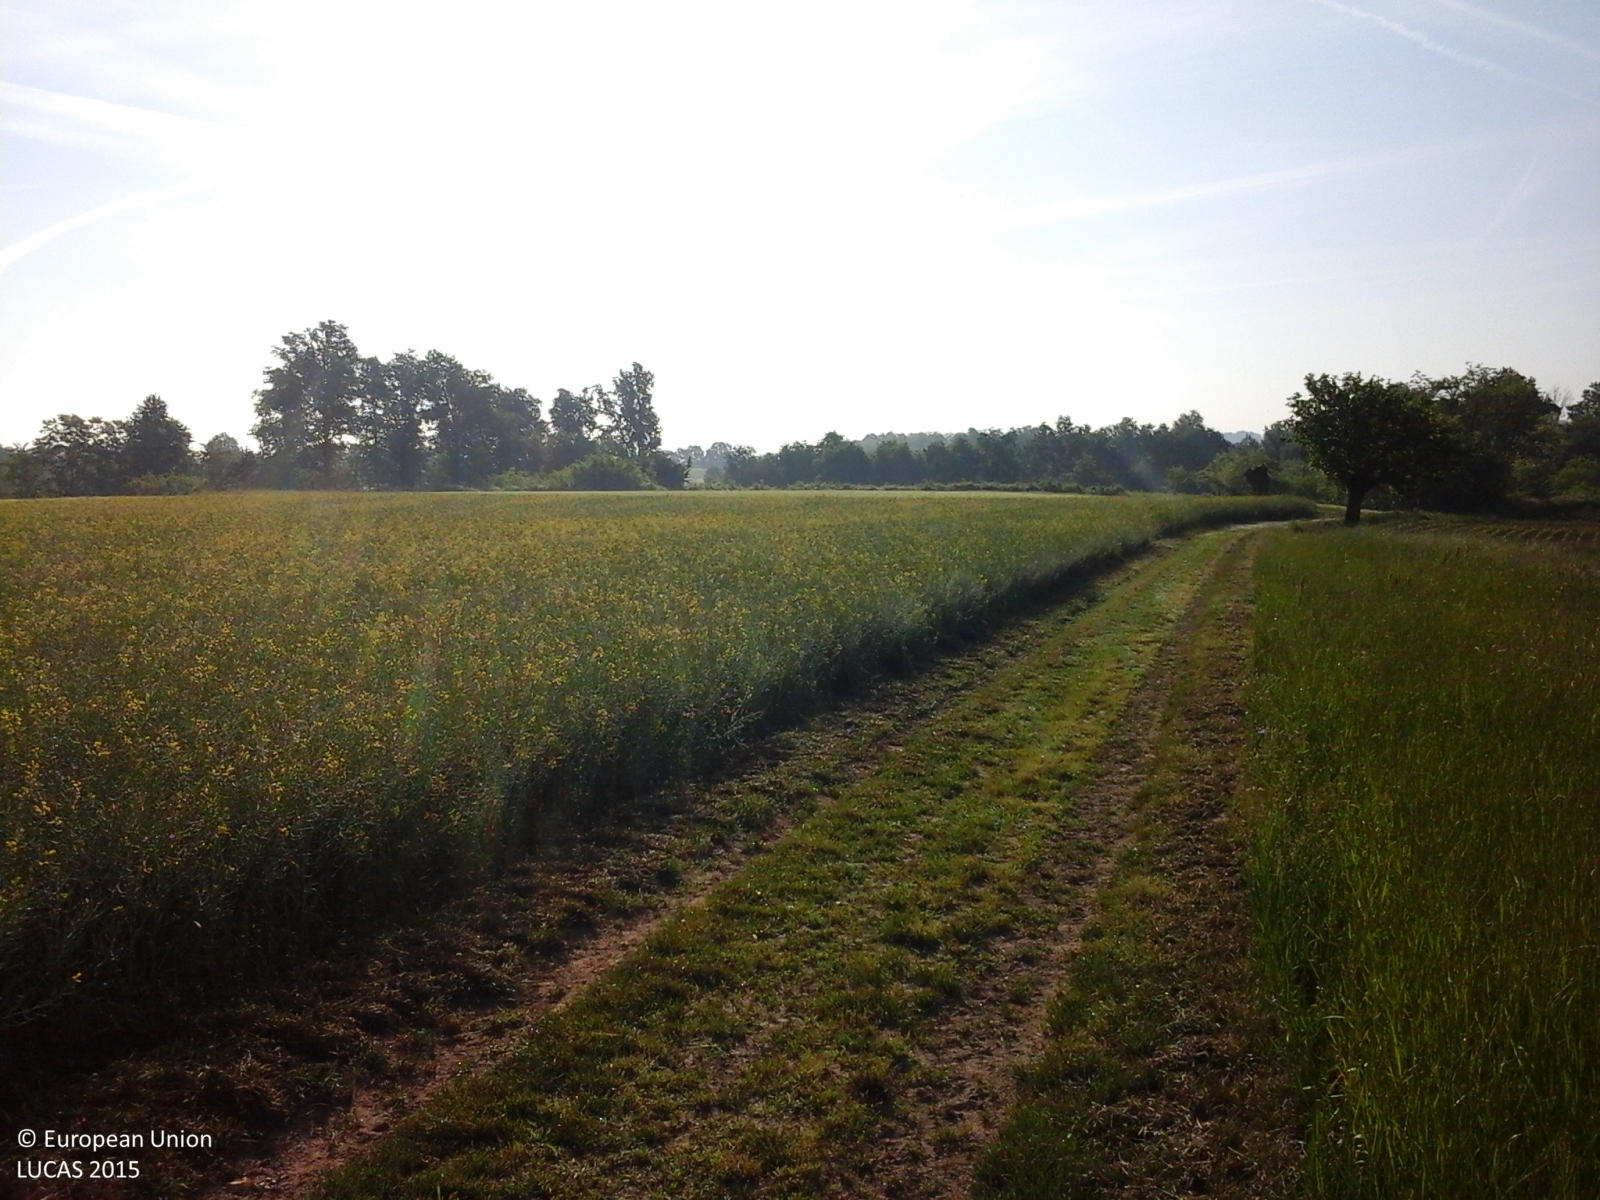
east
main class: Cropland
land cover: Temporary grasslands
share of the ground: > 75 %
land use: Agriculture (excluding fallow land and kitchen gardens)
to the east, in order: Temporary grasslands; Tracks; Rape and turnip rape; Grass margins; Barley; Grassland without tree/shrub cover; Broadleaved woodland; Temporary grasslands
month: May
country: IT
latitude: 44.8926
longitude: 8.1169
